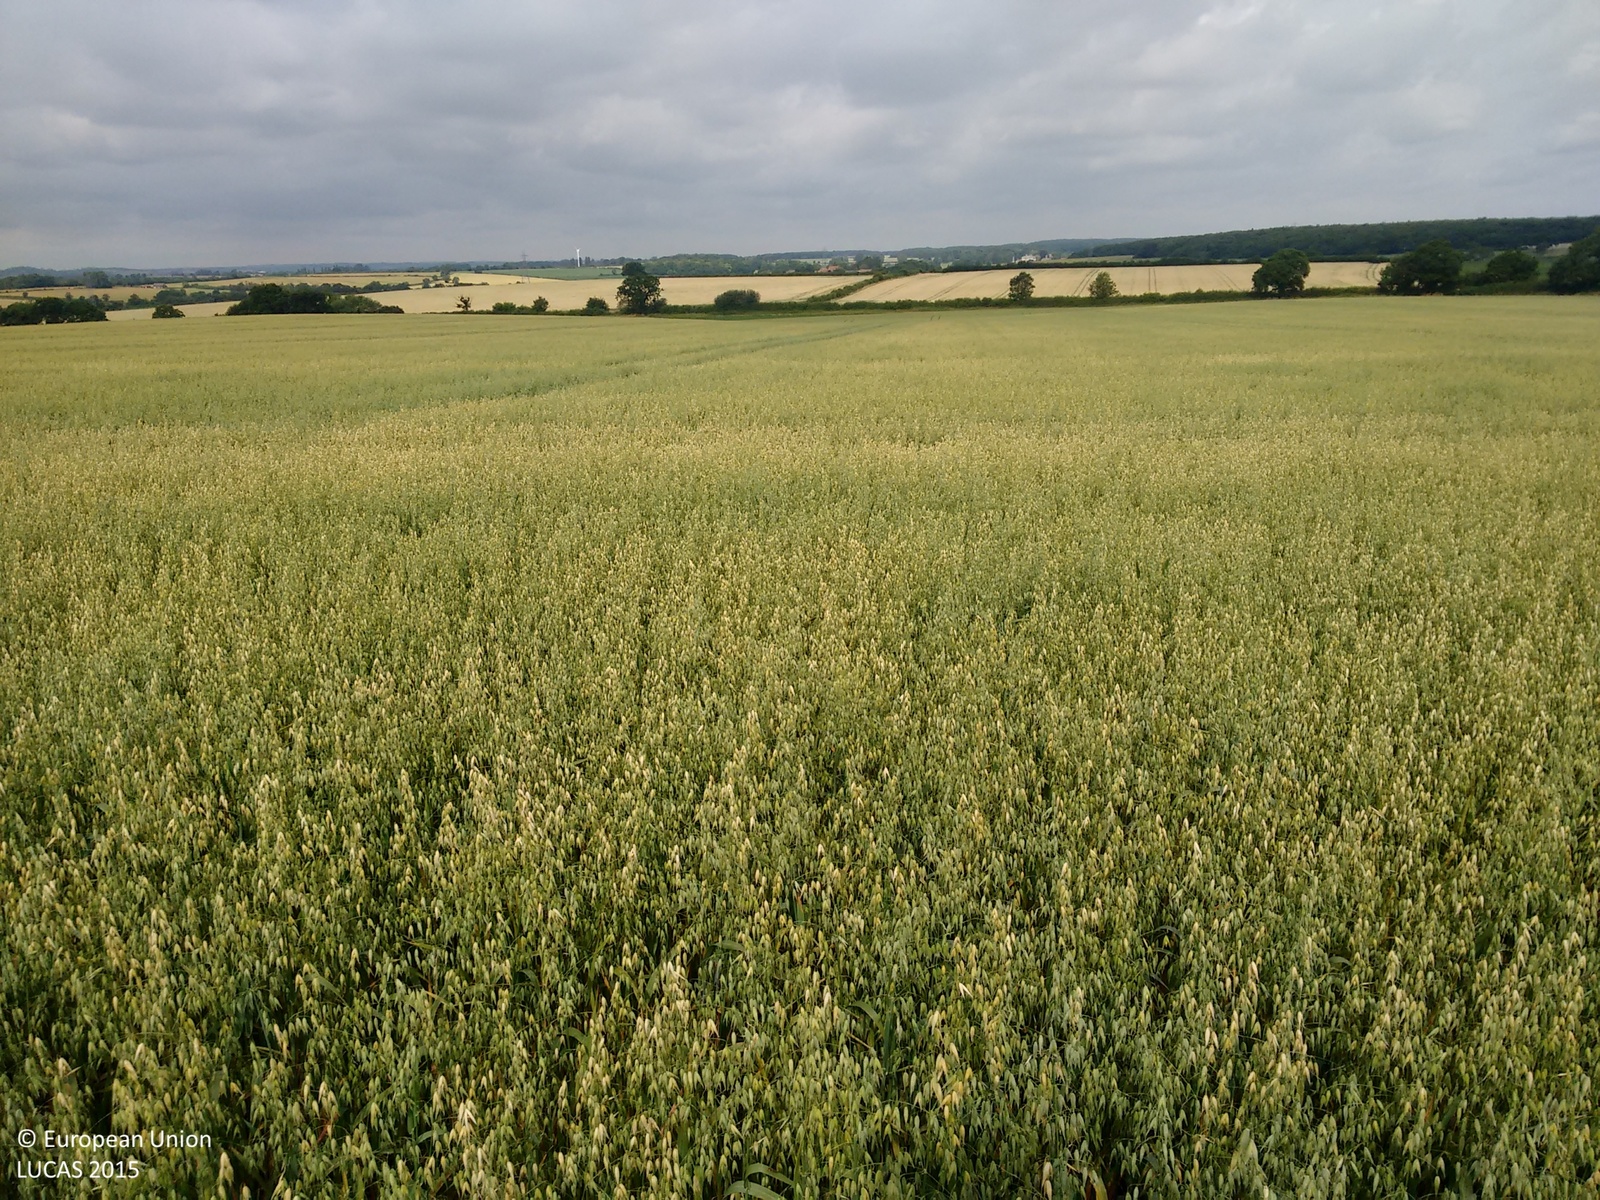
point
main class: Cropland
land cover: Oats
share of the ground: > 75 %
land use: Agriculture (excluding fallow land and kitchen gardens)
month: July
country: GB
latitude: 53.1077
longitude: -0.9023
